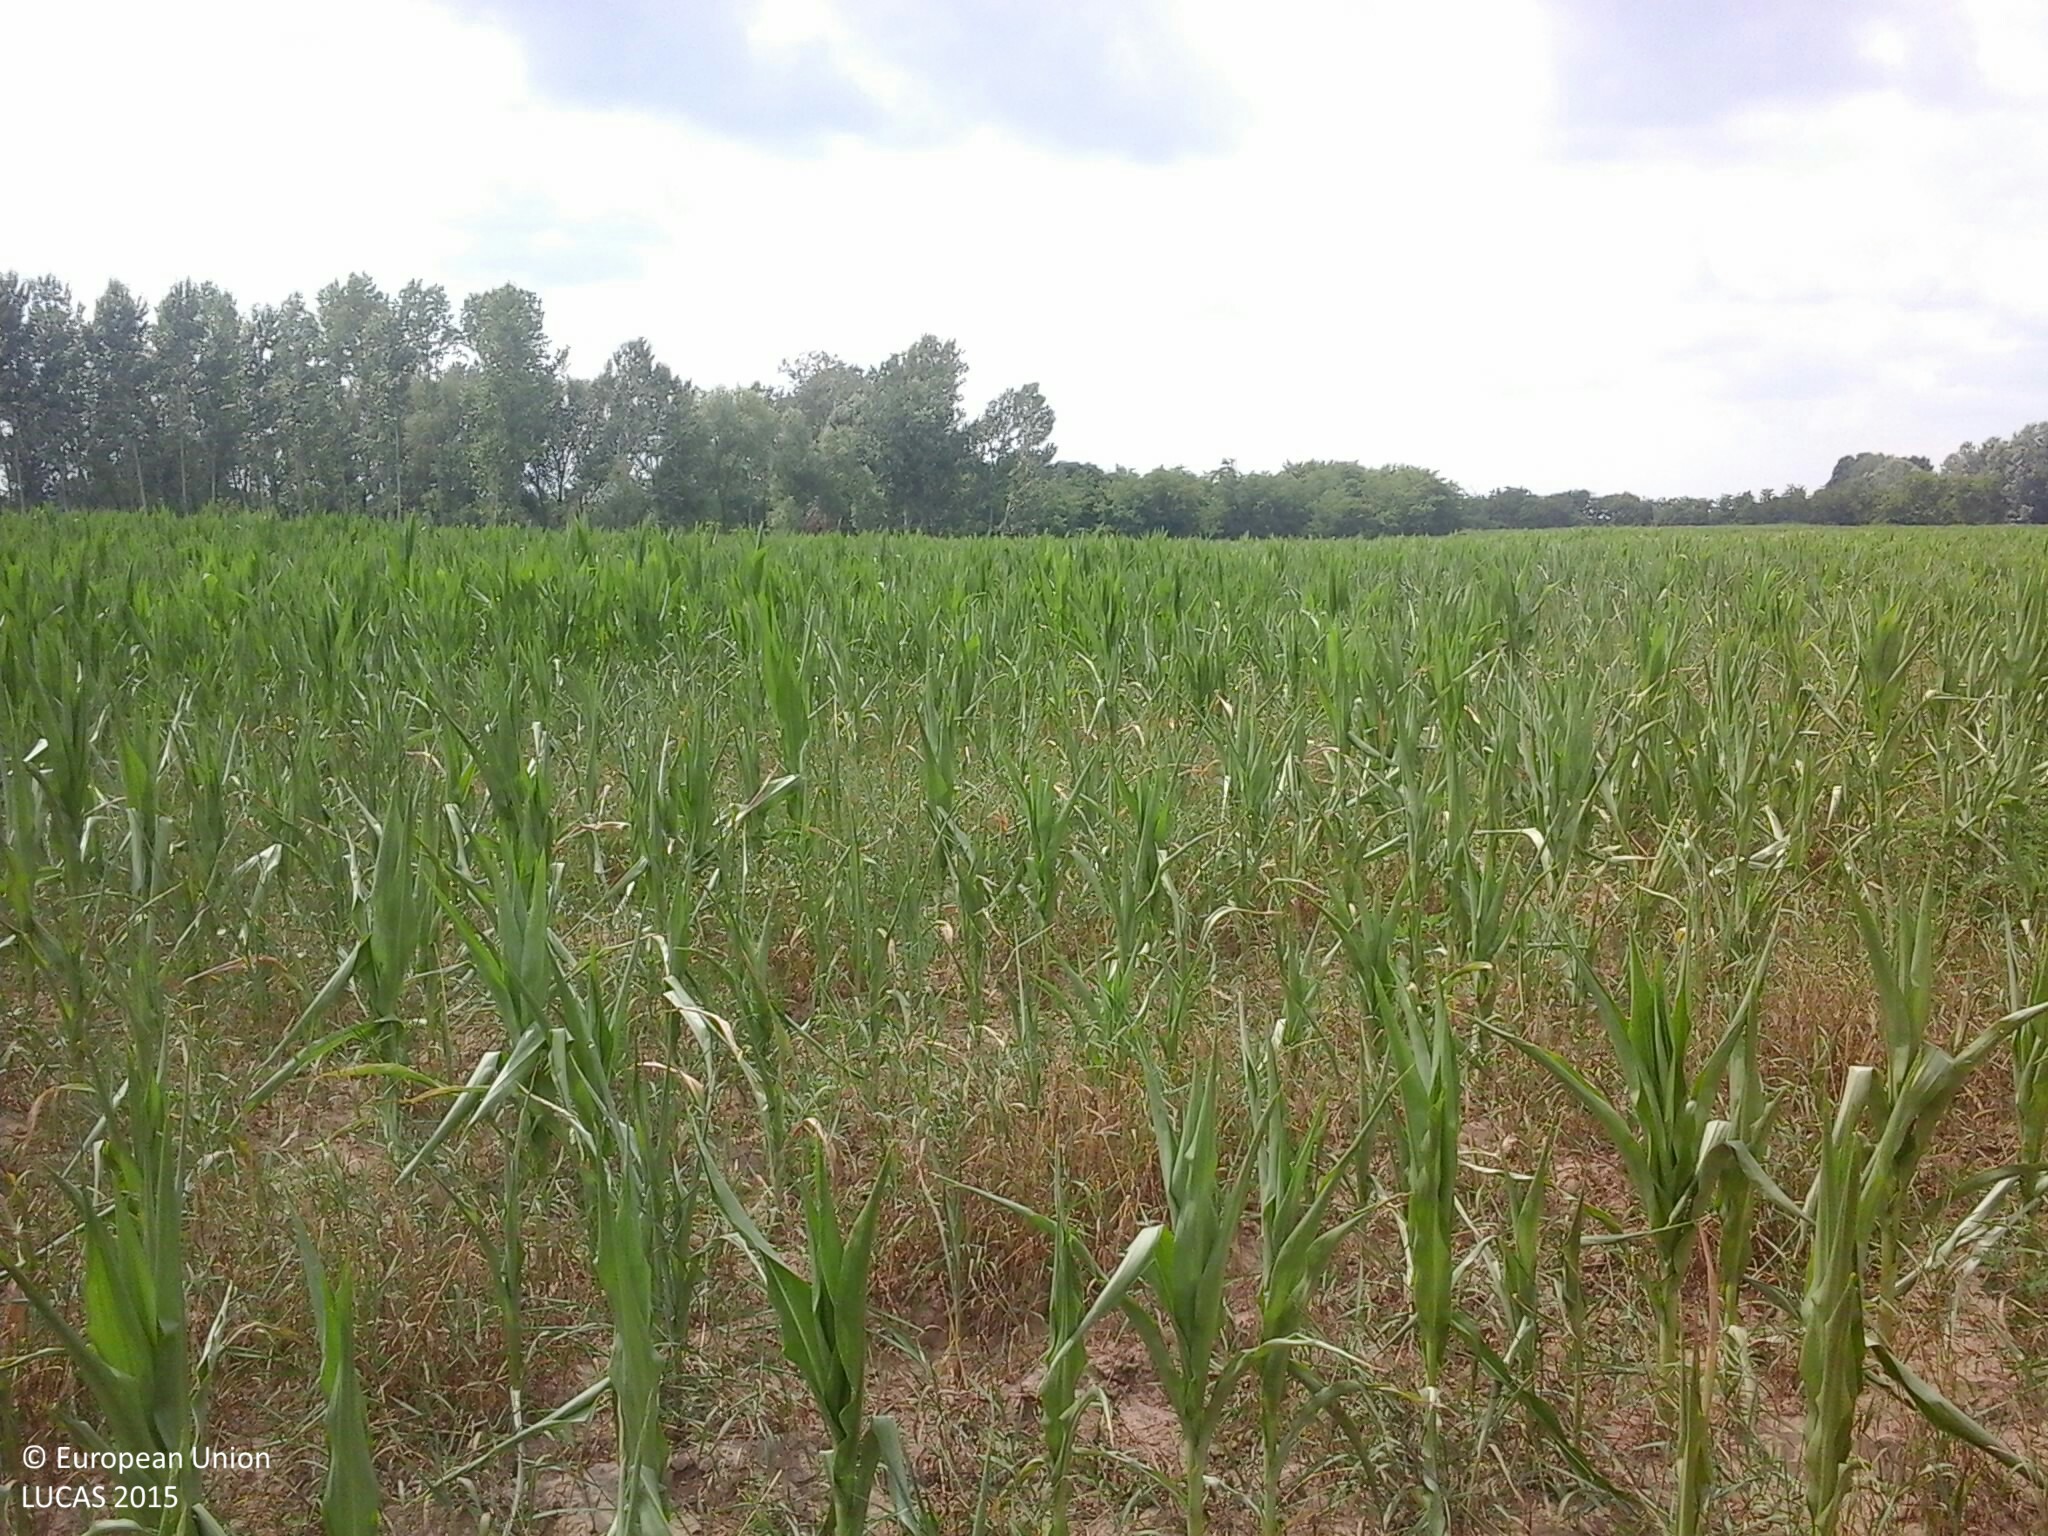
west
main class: Cropland
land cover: Maize
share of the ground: 25 - 50 %
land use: Agriculture (excluding fallow land and kitchen gardens)
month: July
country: HU
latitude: 47.8225
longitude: 22.1413
